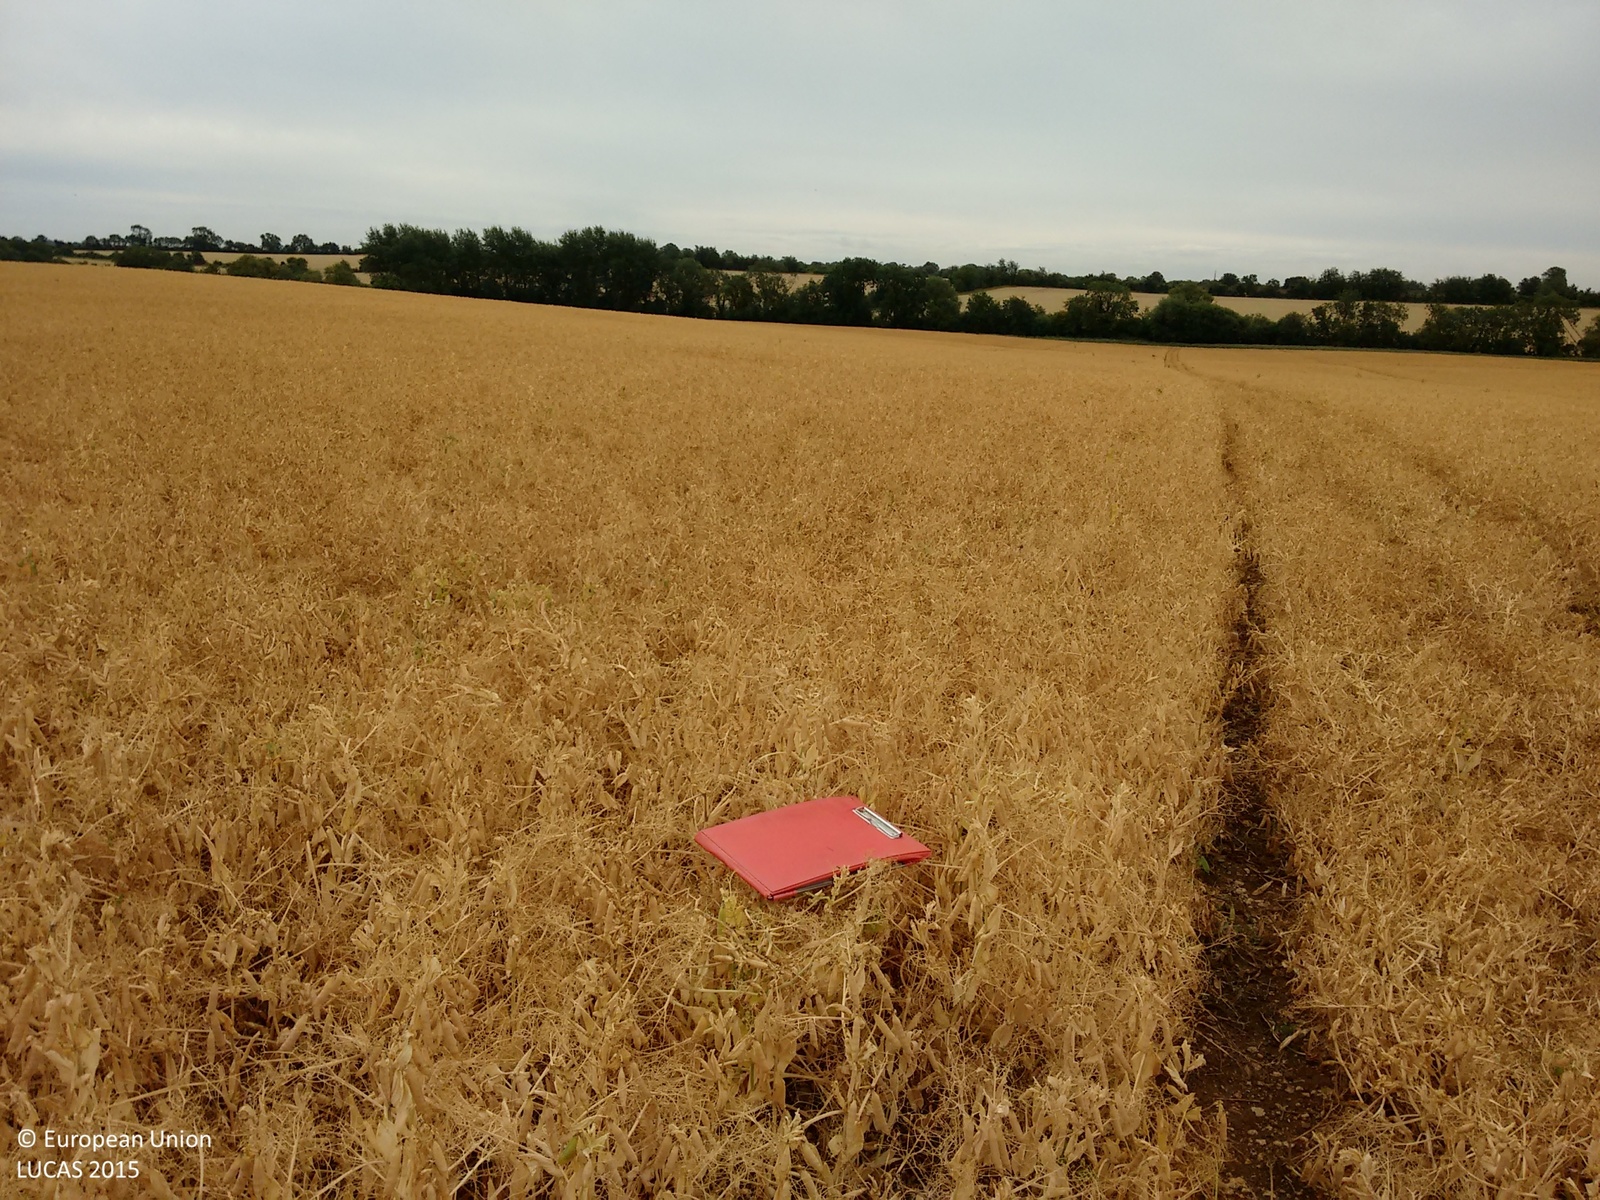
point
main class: Cropland
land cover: Dry pulses
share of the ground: > 75 %
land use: Agriculture (excluding fallow land and kitchen gardens)
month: August
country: GB
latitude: 52.0275
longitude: -1.1967
